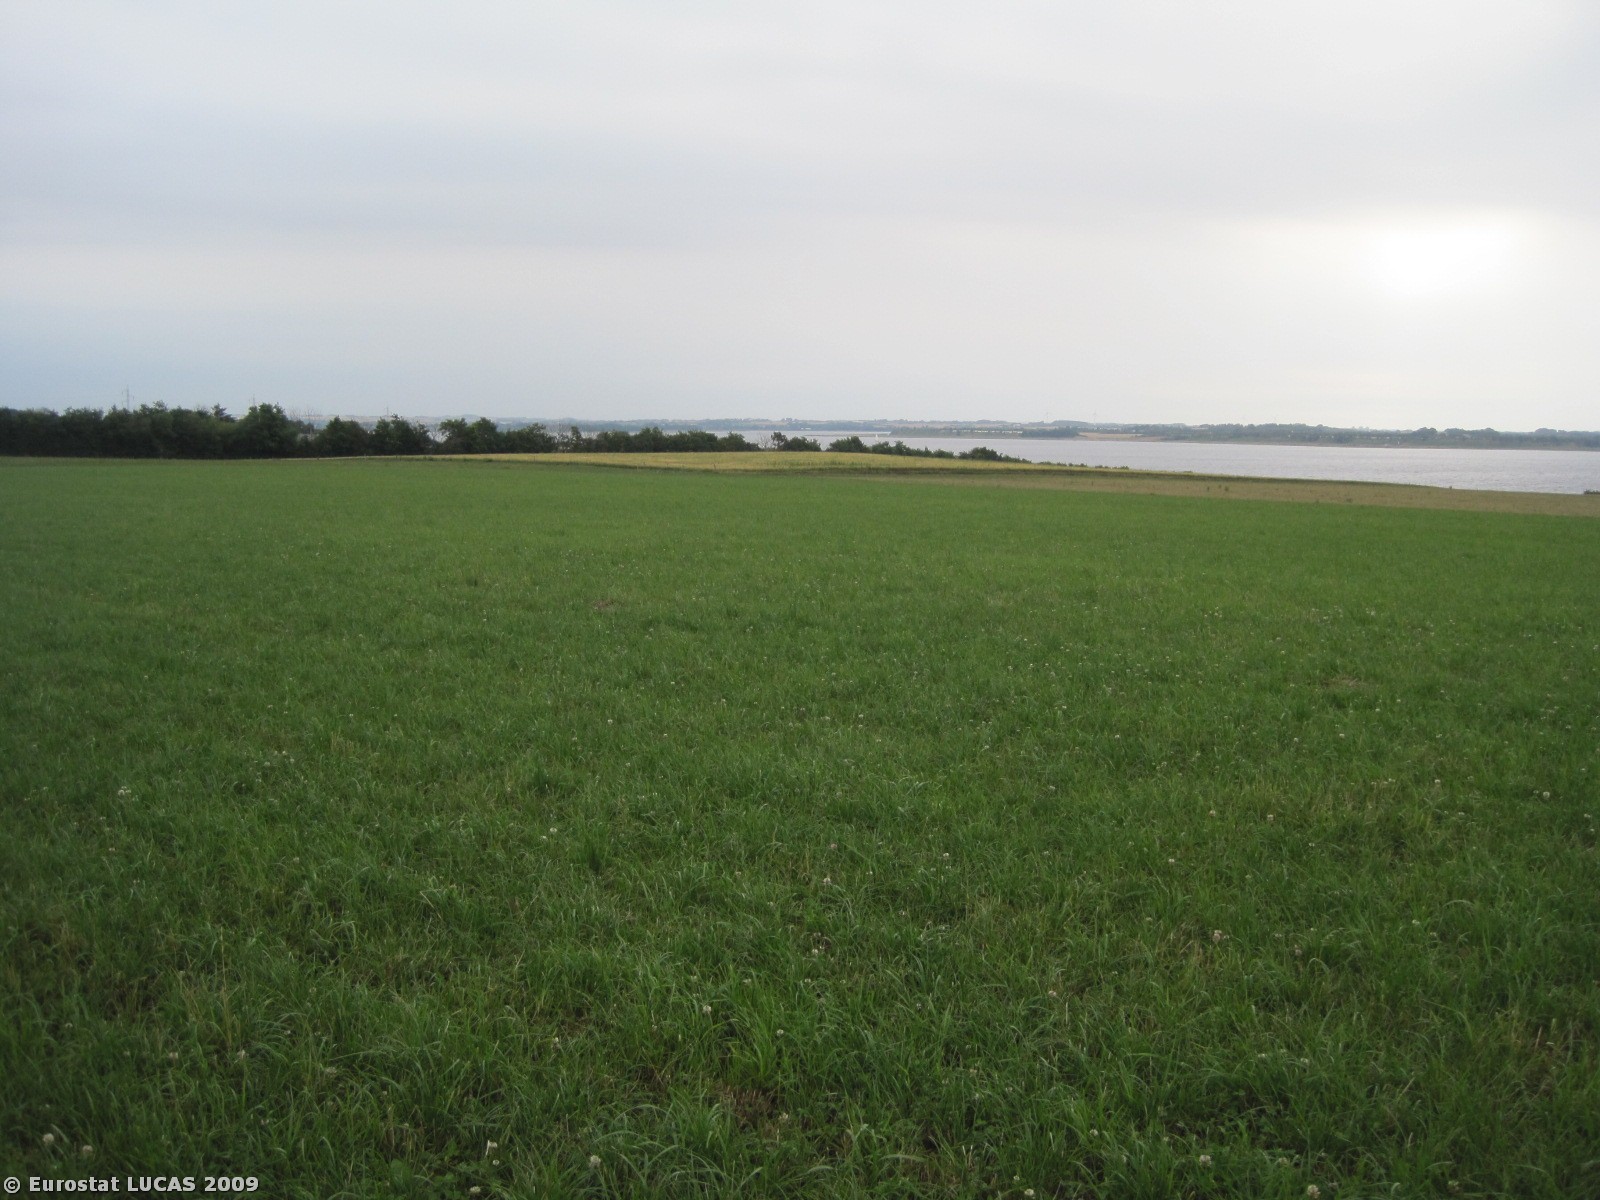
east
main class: Grassland
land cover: Grassland without tree/shrub cover
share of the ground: > 75 %
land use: Agriculture (excluding fallow land and kitchen gardens)
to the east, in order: Grassland without tree/shrub cover; Fences; Grassland without tree/shrub cover; Fences; Grass margins; Barley
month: July
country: DK
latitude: 56.8271
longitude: 8.5763
